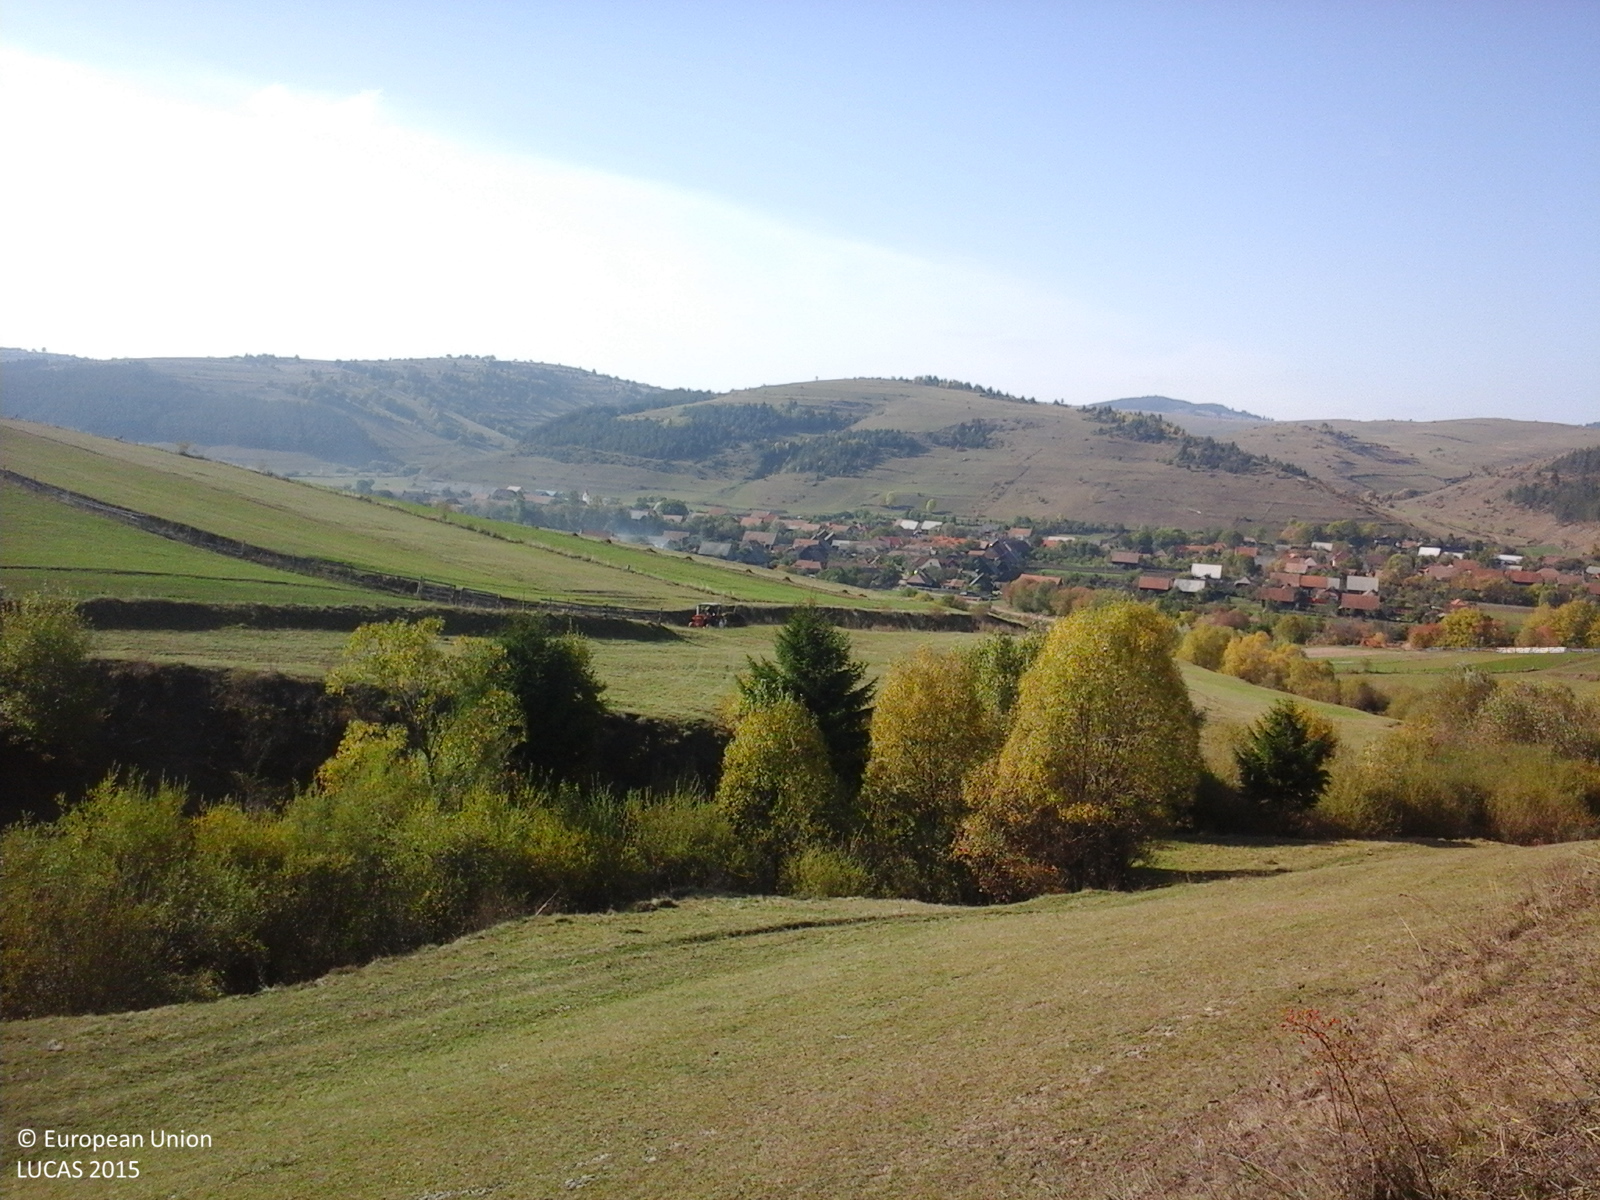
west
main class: Grassland
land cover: Spontaneously vegetated surfaces
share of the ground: > 75 %
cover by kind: herbaceous plants 100 %
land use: Fallow land
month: October
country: RO
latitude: 46.3324
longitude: 25.9806
